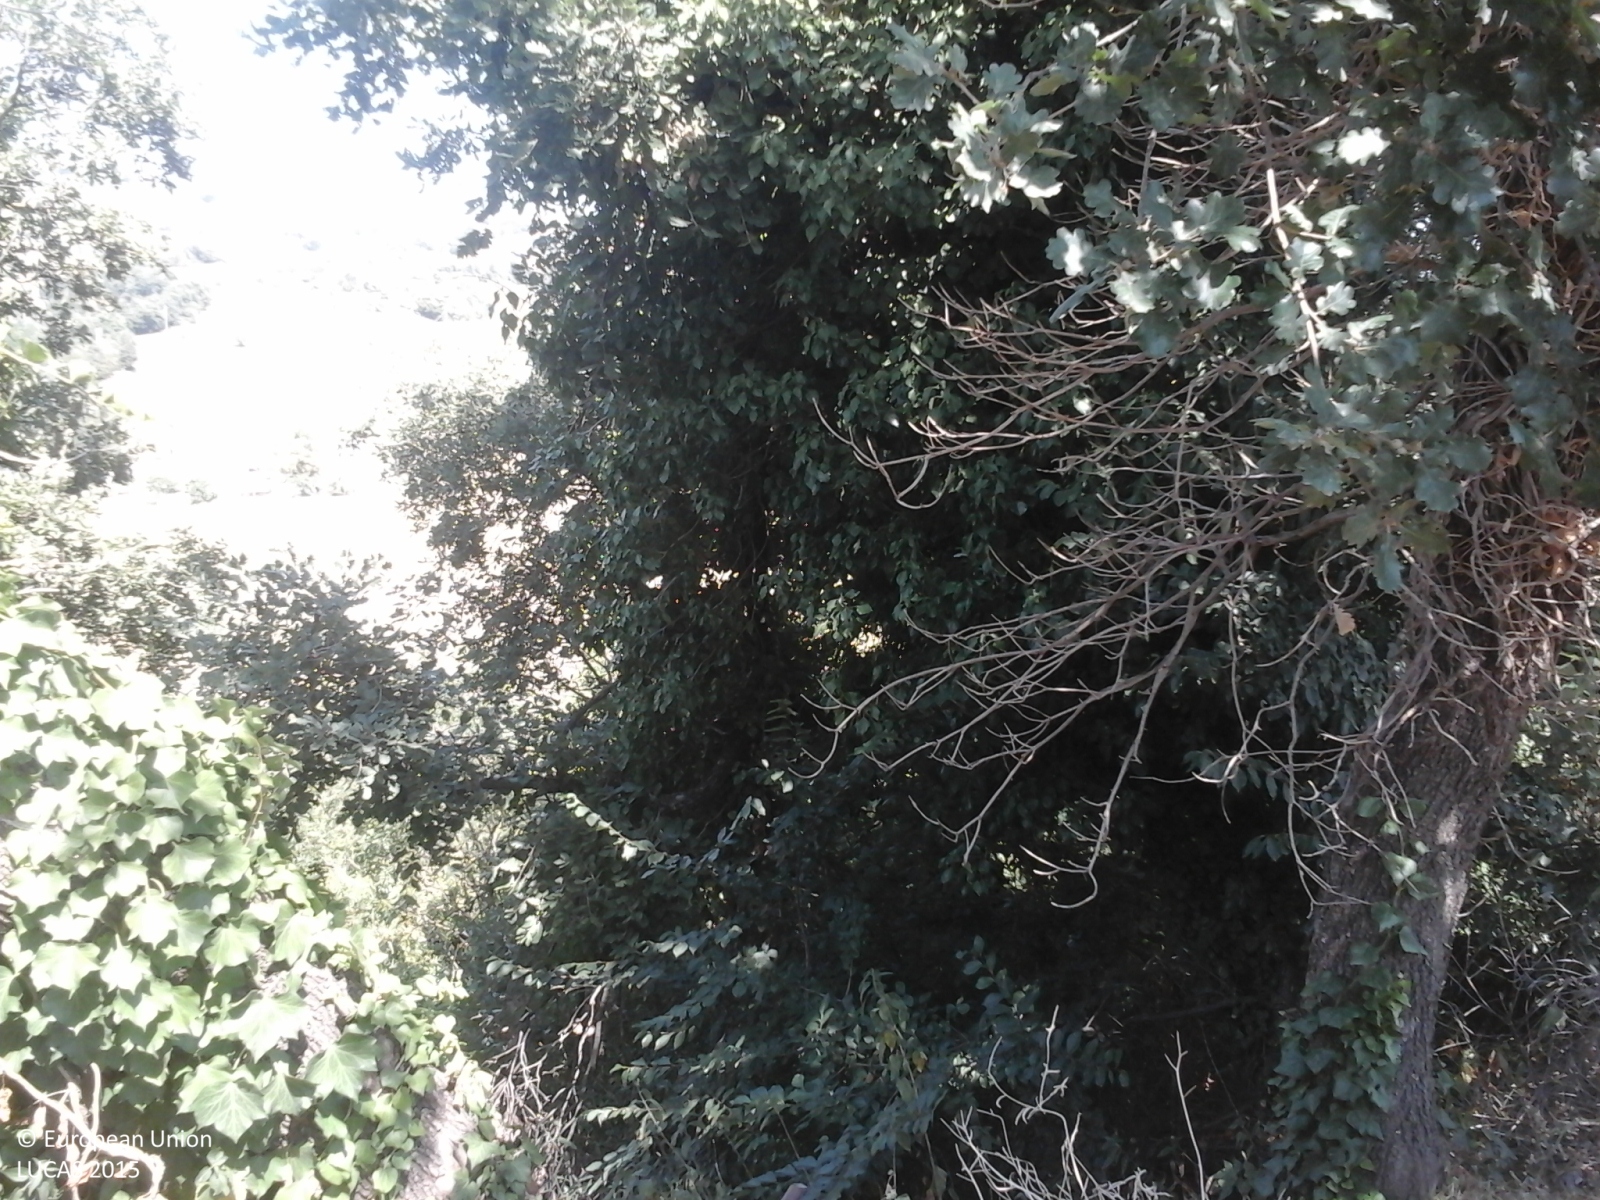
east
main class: Woodland
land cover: Broadleaved woodland
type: thermophilous deciduous forest
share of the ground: > 75 %
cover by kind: broadleaved forest trees 80 %, shrubs 10 %, herbaceous plants 10 %
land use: Semi-natural and natural areas not in use
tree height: > 5 m
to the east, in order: Broadleaved woodland; Rivers and streams; Broadleaved woodland; Rivers and streams; Broadleaved woodland
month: August
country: IT
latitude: 42.4337
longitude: 13.9144
